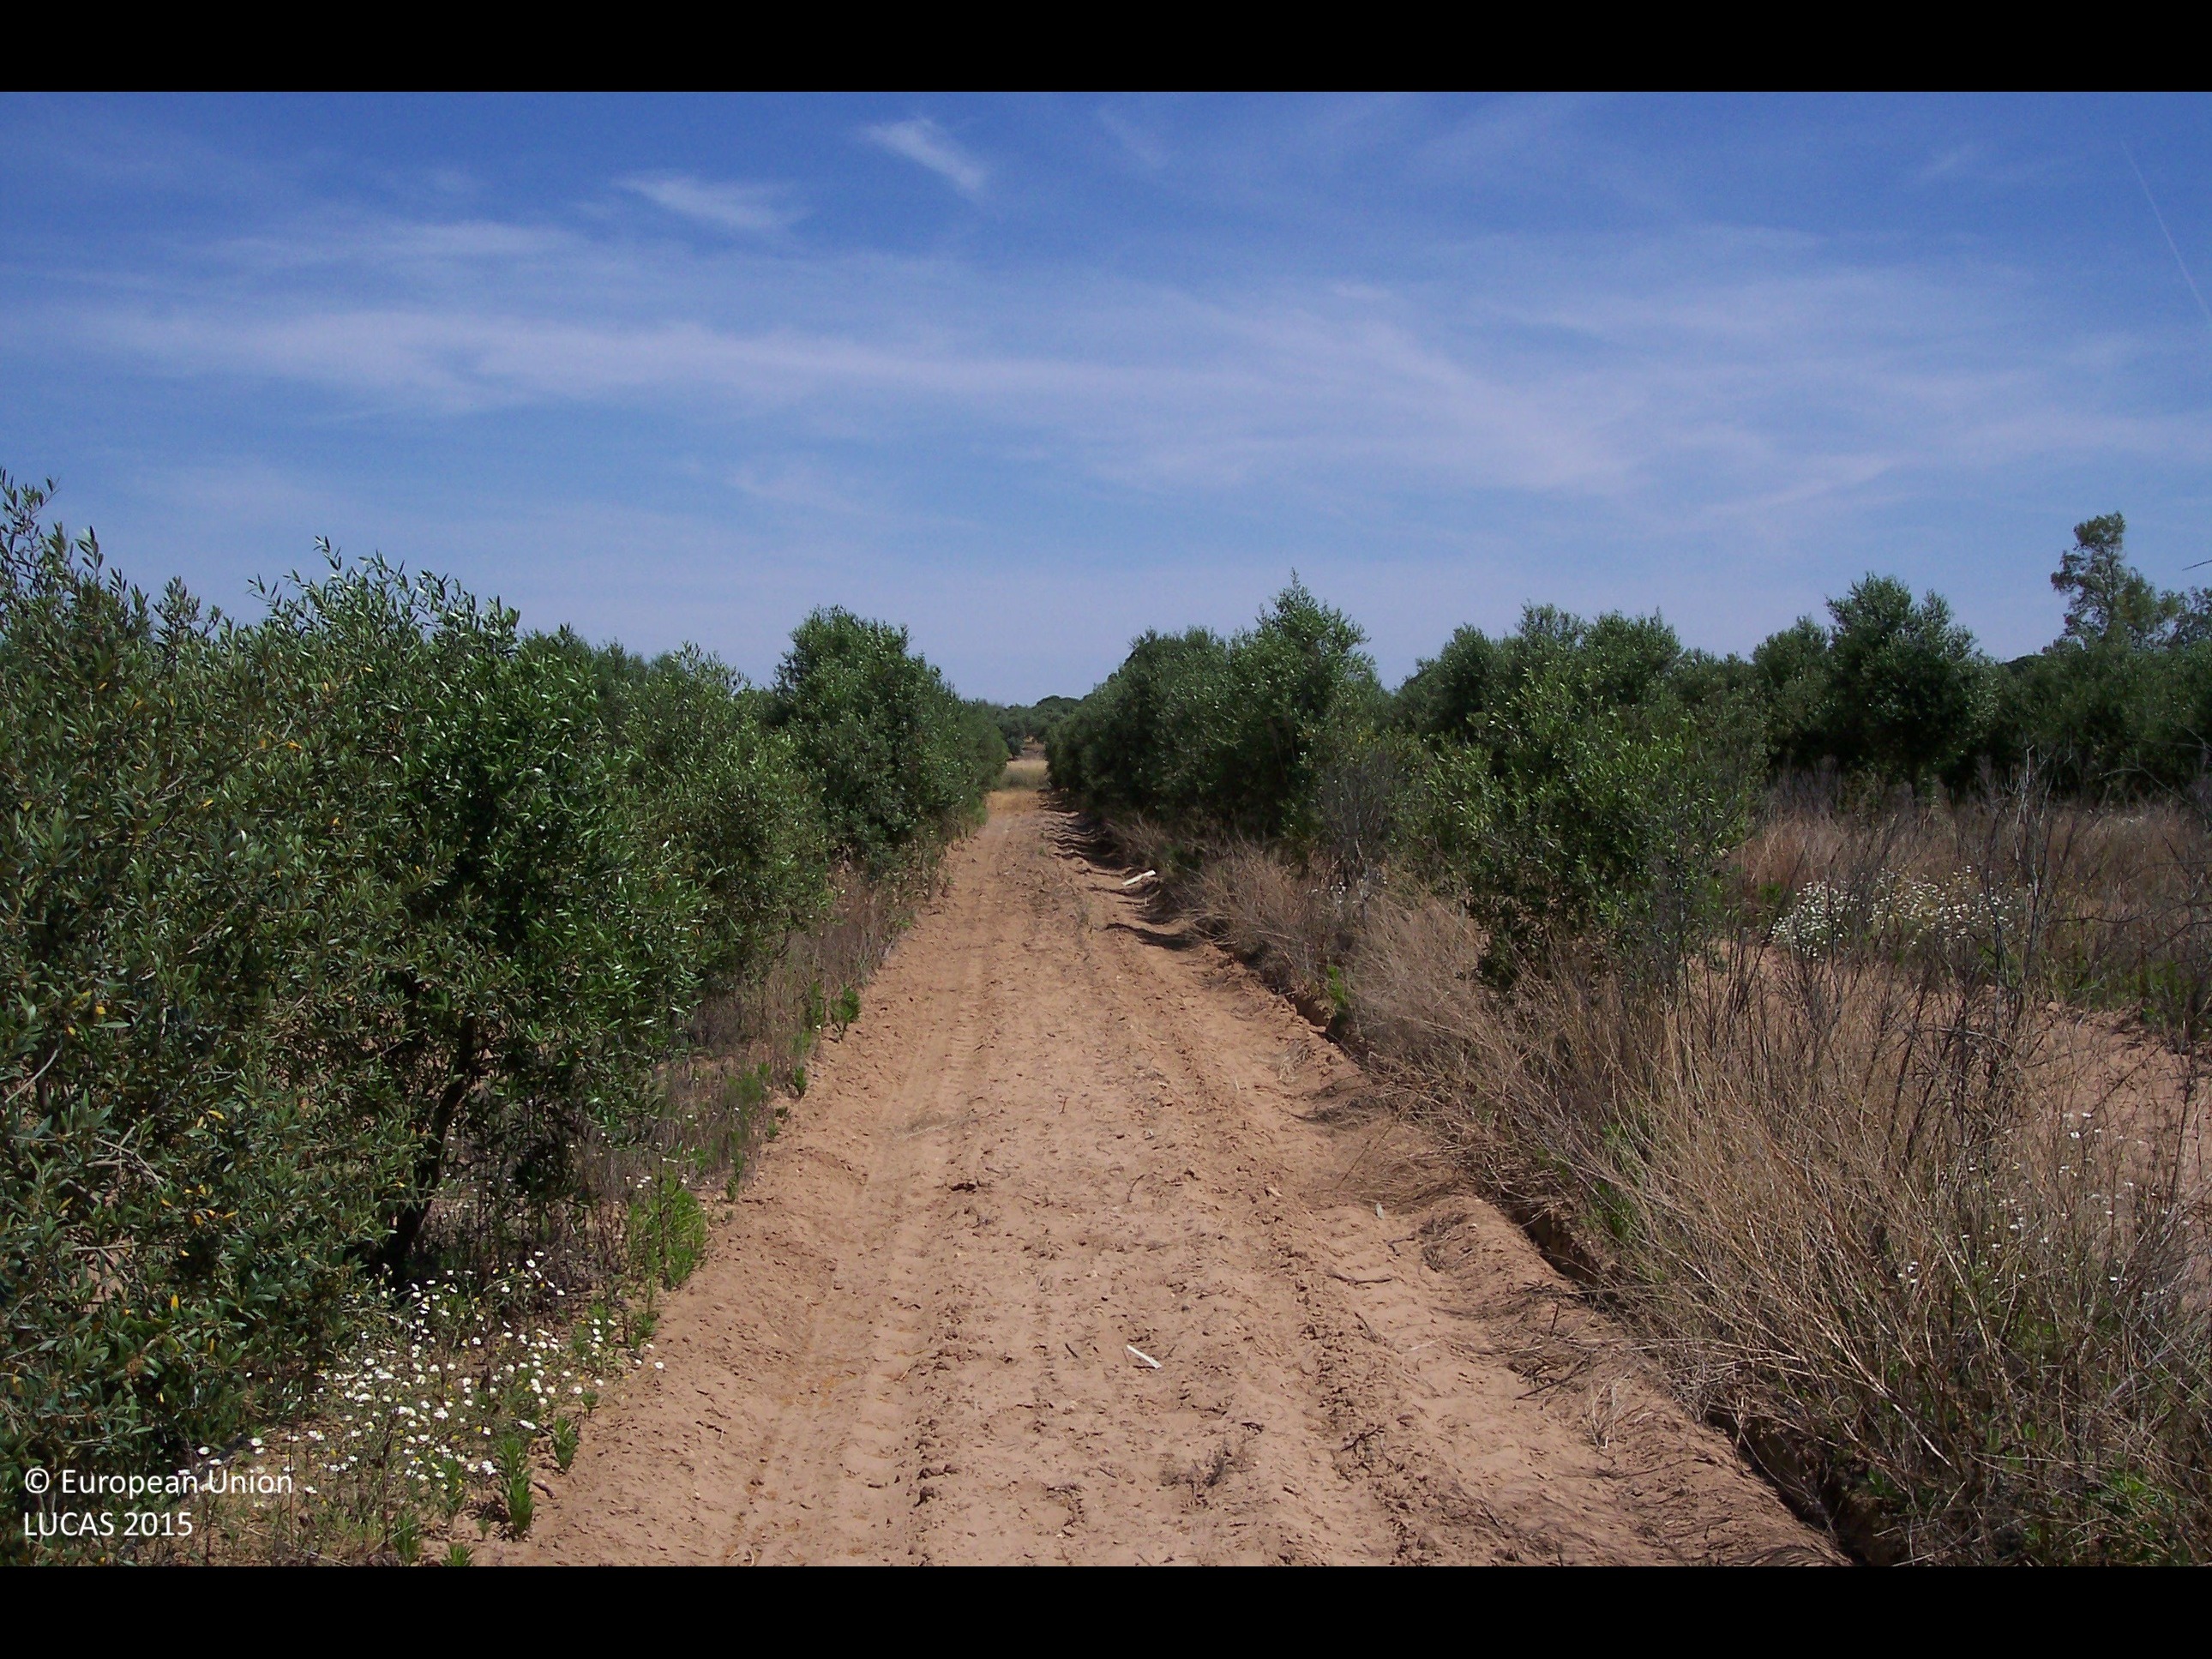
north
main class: Cropland
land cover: Olive groves
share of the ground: 25 - 50 %
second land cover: Spontaneously vegetated surfaces
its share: 10 - 25 %
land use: Agriculture (excluding fallow land and kitchen gardens)
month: May
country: ES
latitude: 37.2199
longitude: -5.8519
